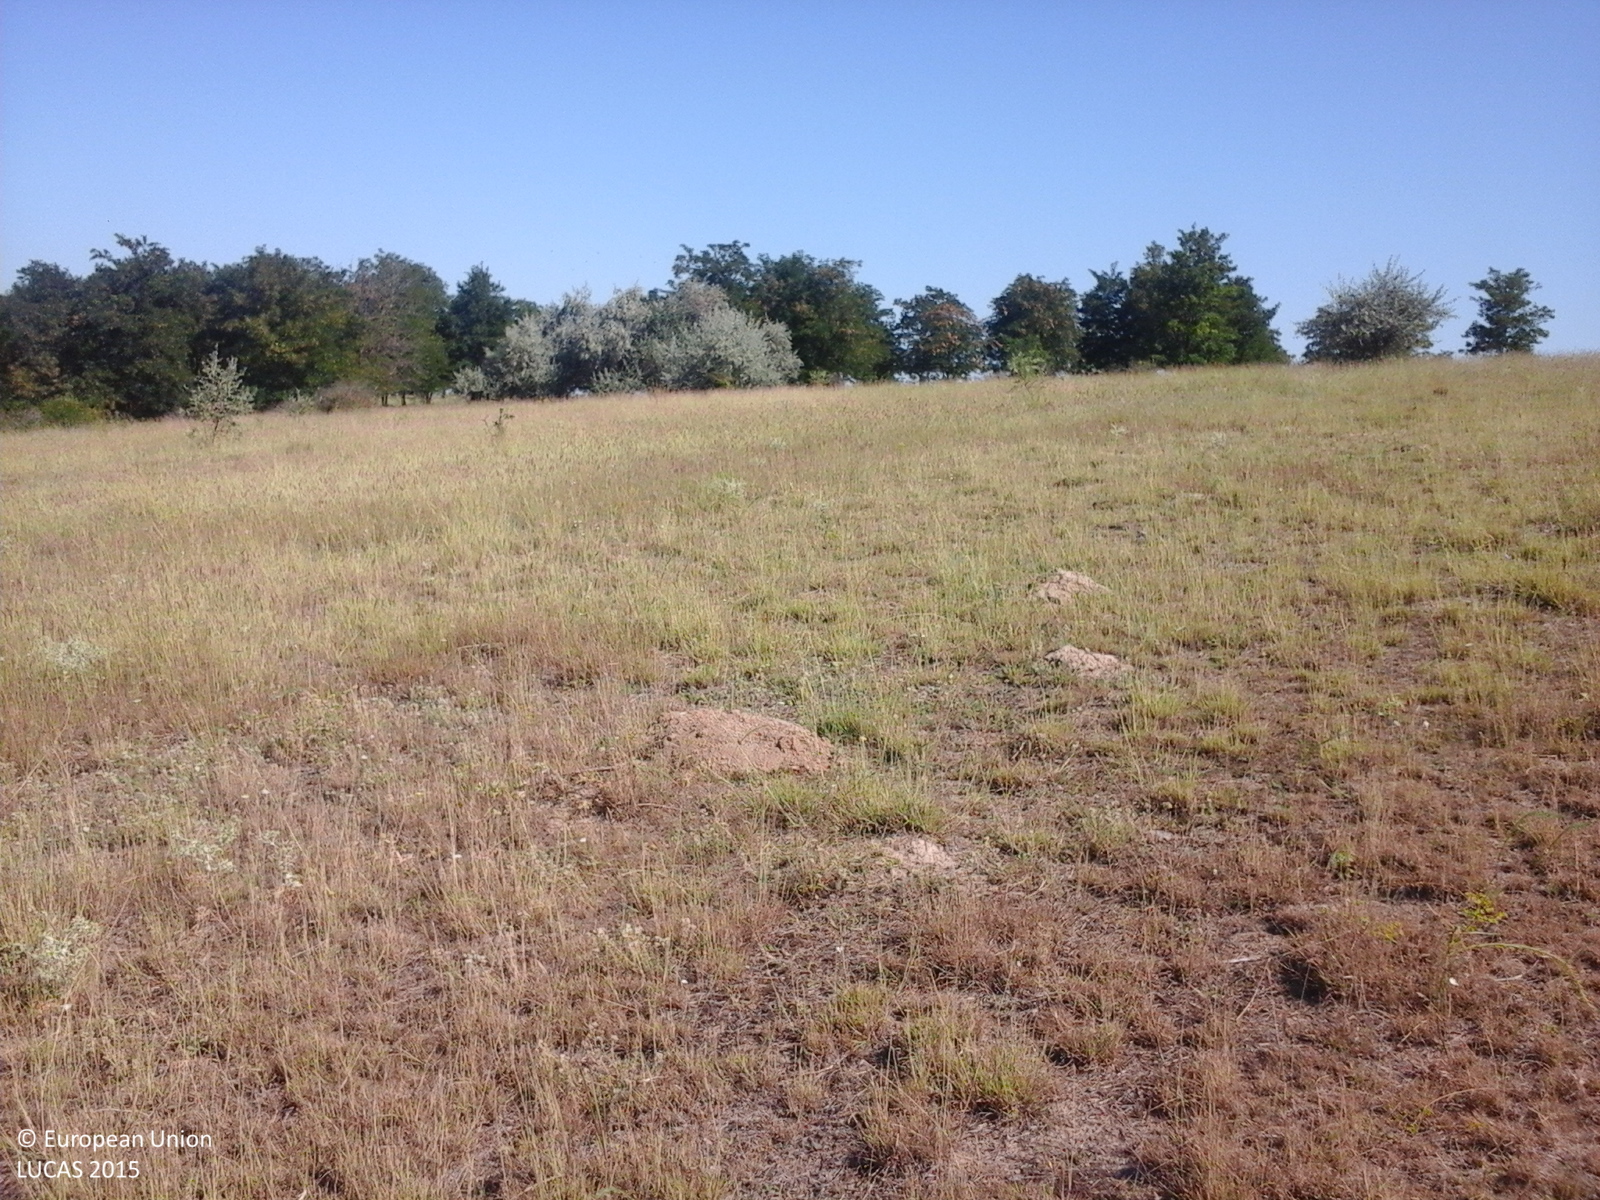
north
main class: Grassland
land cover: Grassland without tree/shrub cover
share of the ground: > 75 %
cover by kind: herbaceous plants 100 %
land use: Agriculture (excluding fallow land and kitchen gardens)
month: August
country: RO
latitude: 44.6594
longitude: 28.0050
